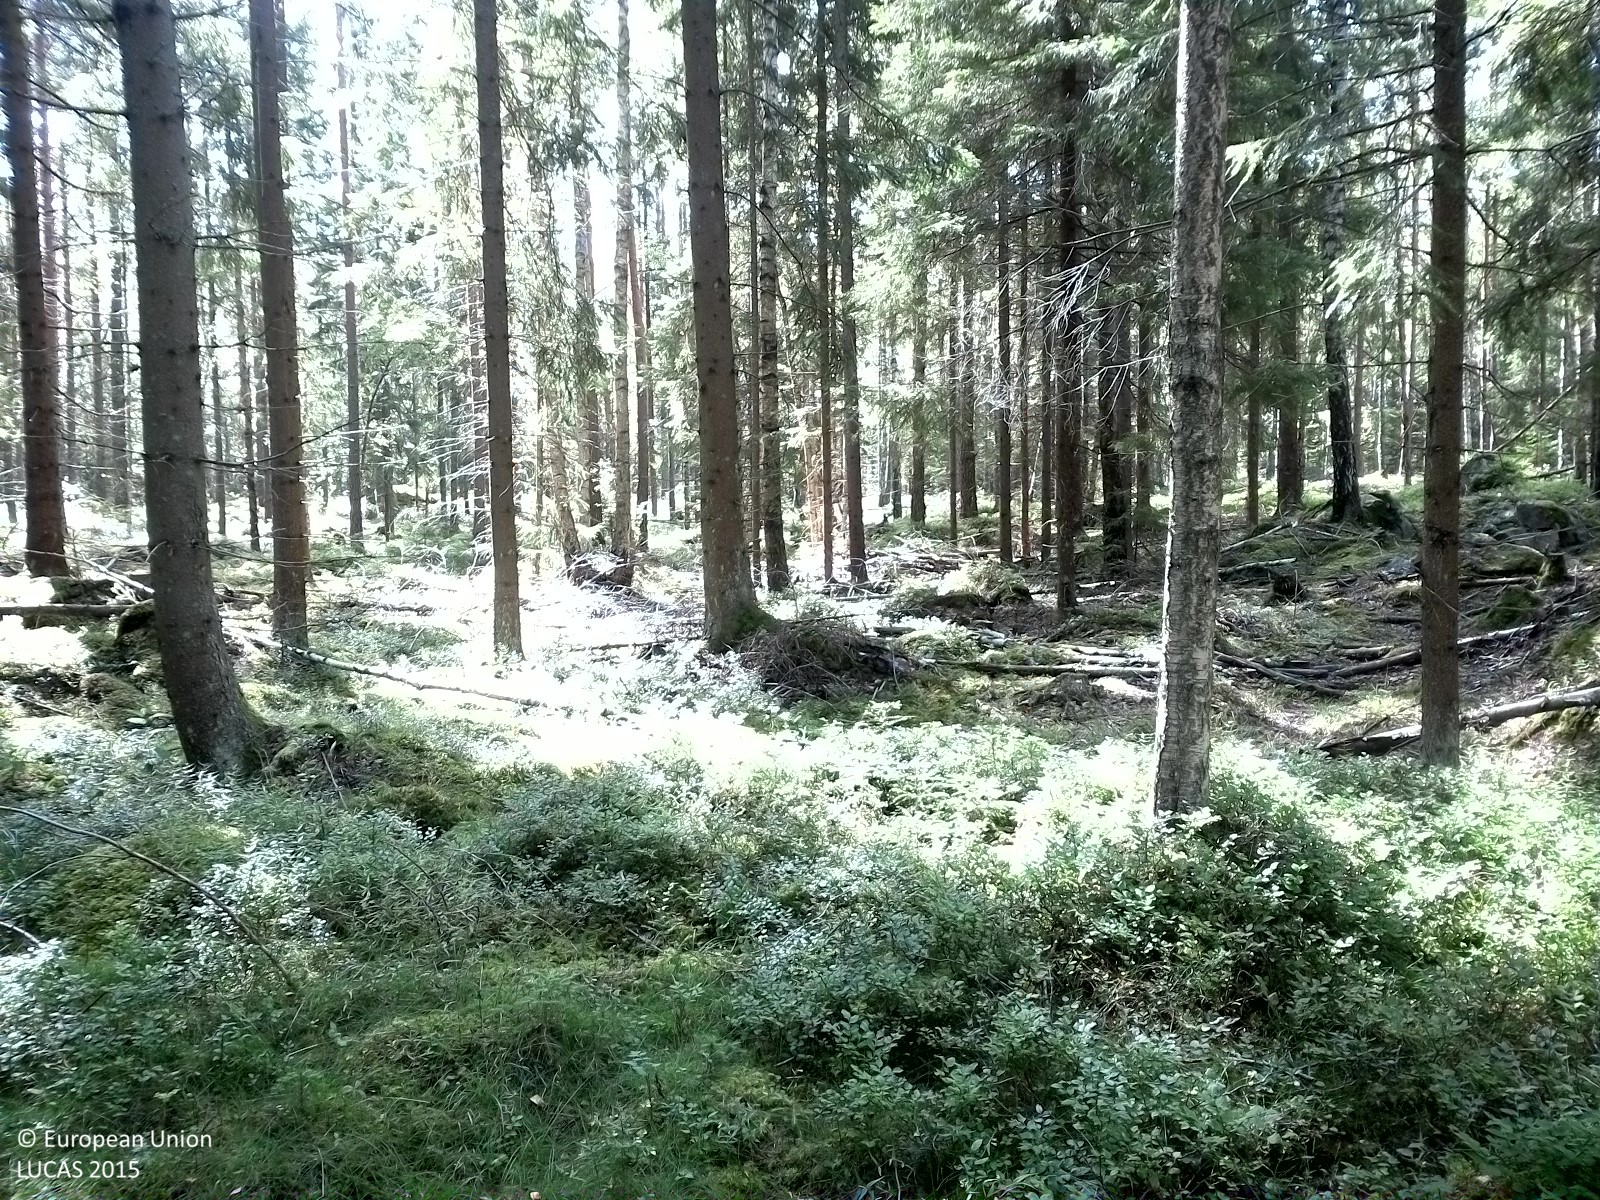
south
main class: Woodland
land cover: Spruce dominated mixed woodland
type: boreal forest
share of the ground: 25 - 50 %
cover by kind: herbaceous plants 35 %, coniferous forest trees 30 %, broadleaved forest trees 15 %, lichens and mosses 15 %, shrubs 5 %
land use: Forestry
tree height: > 5 m
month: August
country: SE
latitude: 59.0424
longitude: 15.0989
